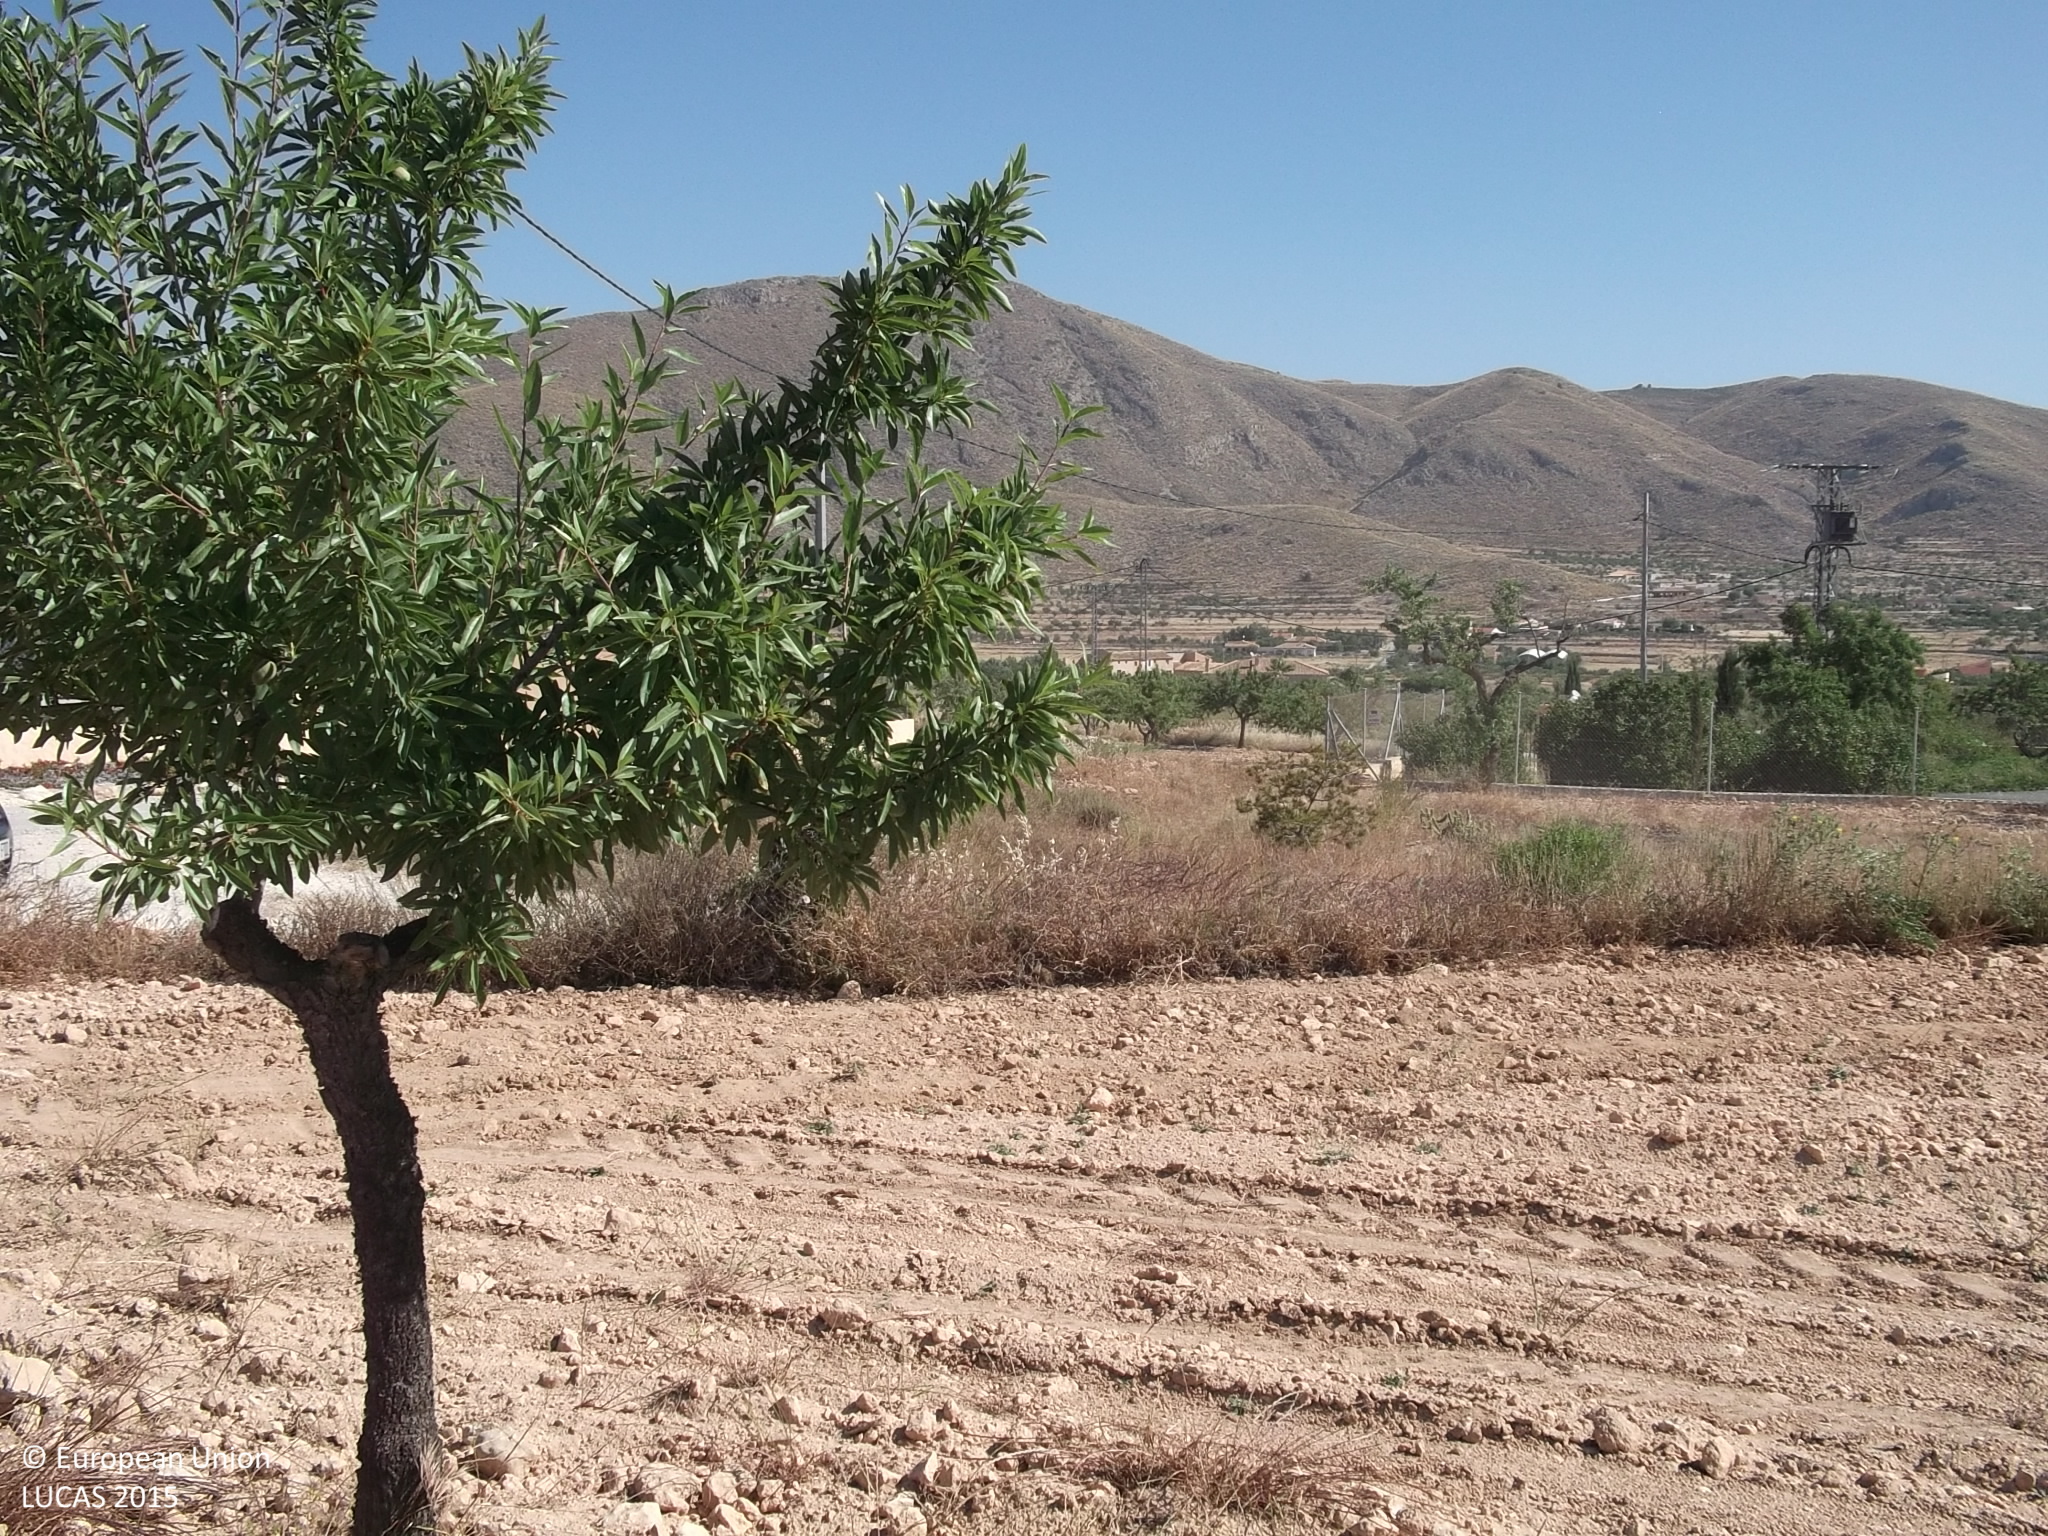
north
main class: Cropland
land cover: Nuts trees
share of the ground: 10 - 25 %
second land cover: Other bare soil
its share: > 75 %
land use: Agriculture (excluding fallow land and kitchen gardens)
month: May
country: ES
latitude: 38.2652
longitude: -0.9471
